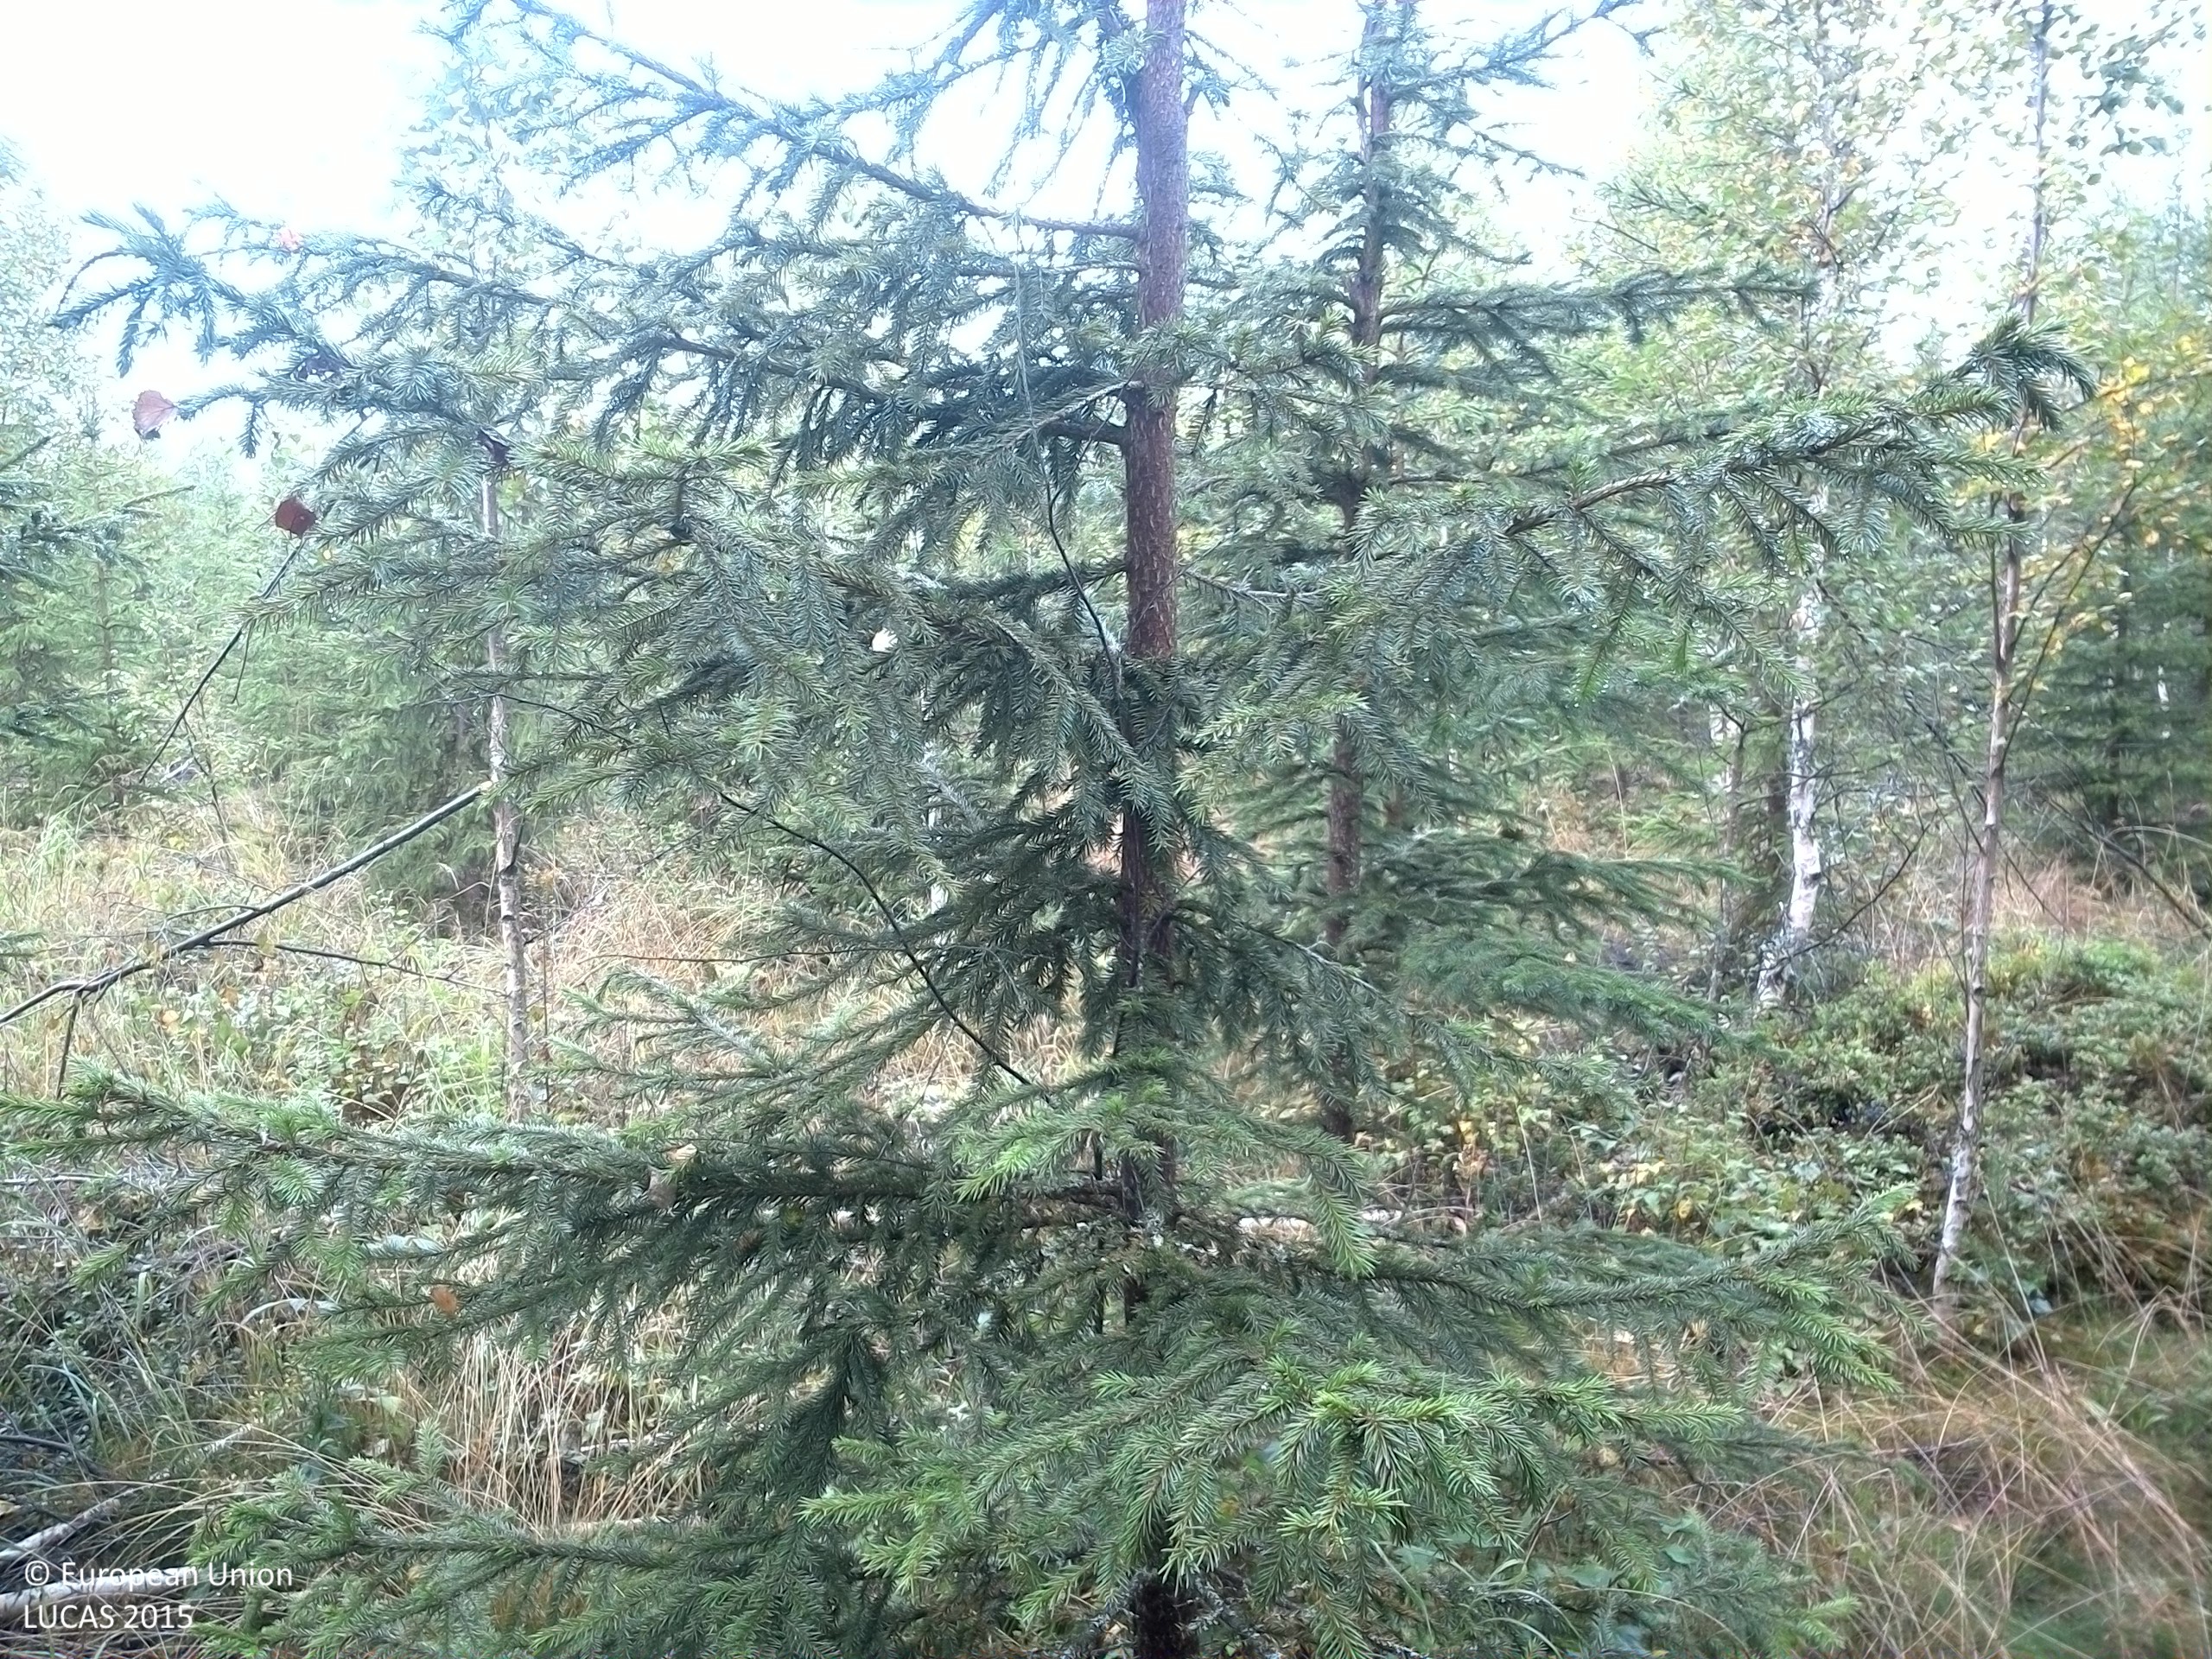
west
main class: Woodland
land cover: Spruce dominated mixed woodland
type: boreal forest
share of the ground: 50 - 75 %
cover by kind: coniferous forest trees 40 %, broadleaved forest trees 20 %, shrubs 20 %, herbaceous plants 10 %, lichens and mosses 10 %
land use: Forestry
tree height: < 5 m
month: September
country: SE
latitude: 61.6549
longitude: 15.2135
